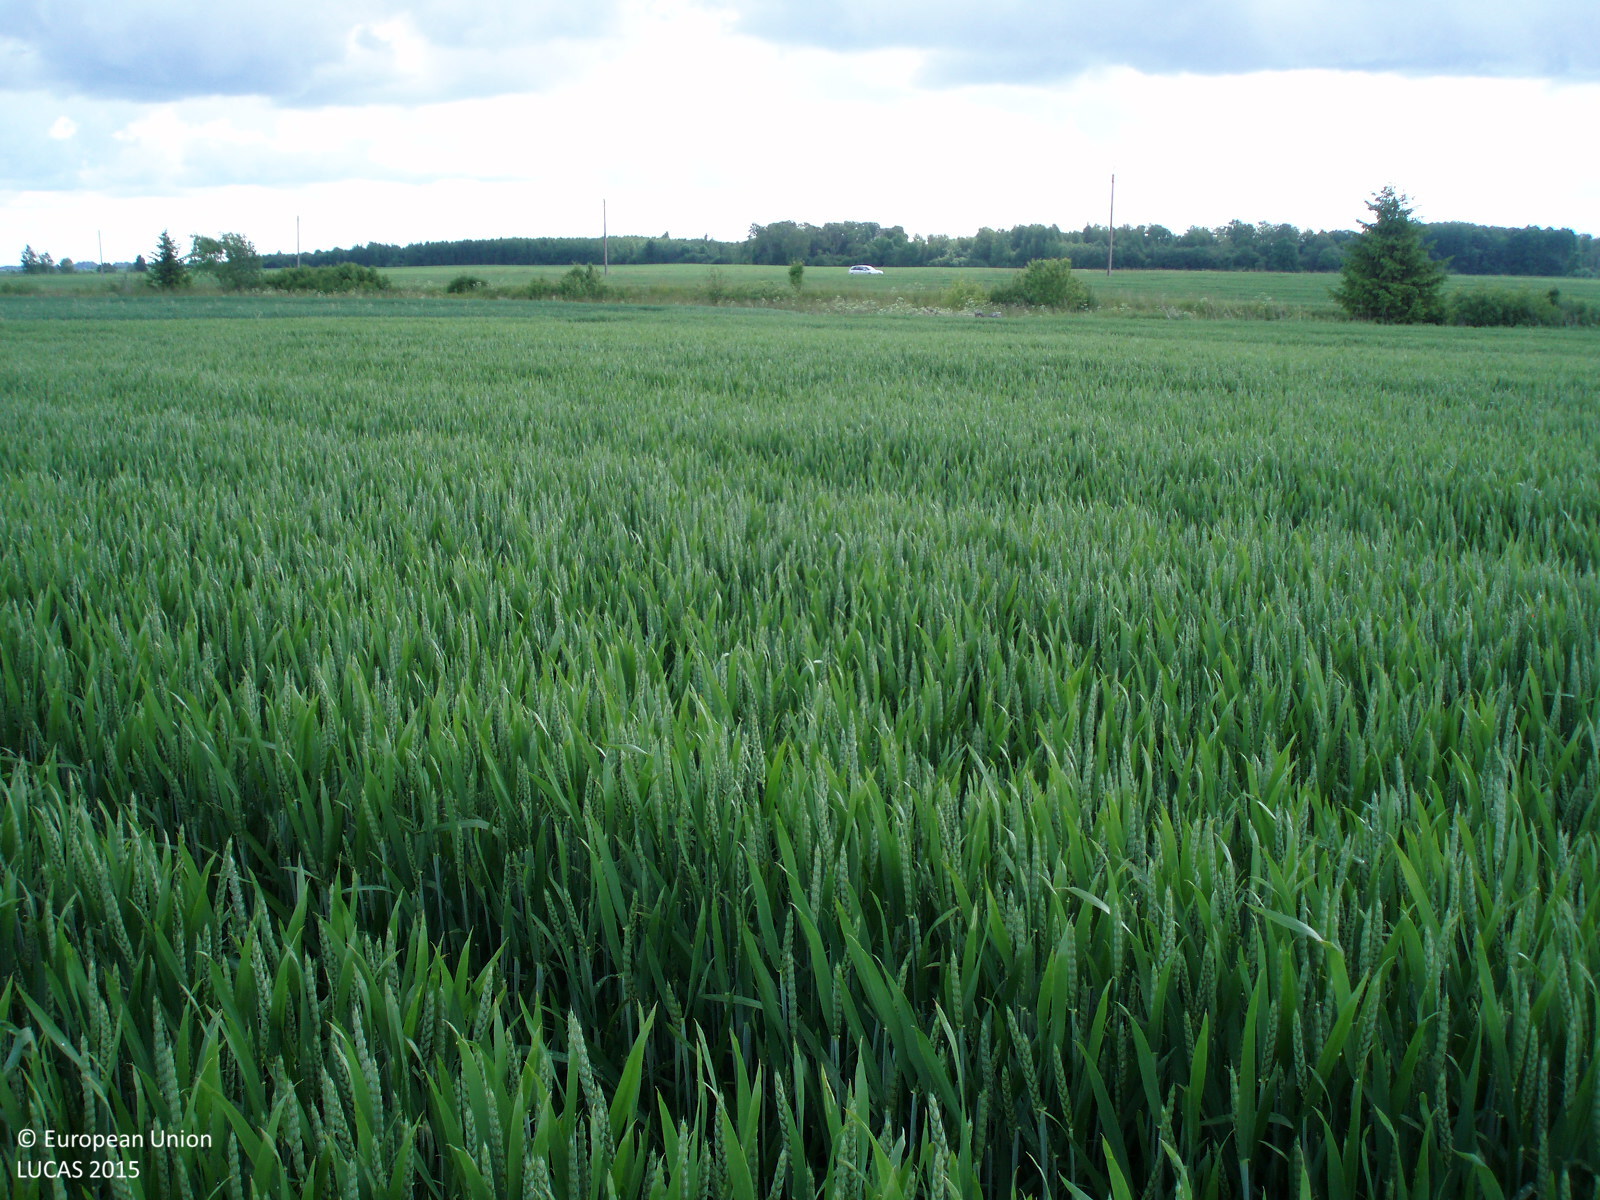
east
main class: Cropland
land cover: Common wheat
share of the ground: > 75 %
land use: Agriculture (excluding fallow land and kitchen gardens)
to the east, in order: Common wheat; Grass margins; Grassland with sparse tree/shrub cover; Ditches and canals; Grassland with sparse tree/shrub cover; Grass margins; Common wheat; Electric lines; Common wheat; Grass margins; Paved roads, cycling and walking lanes; Grass margins; Barley; Grass margins; Paved roads, cycling and walking lanes
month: June
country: LT
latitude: 56.2972
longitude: 23.2736
